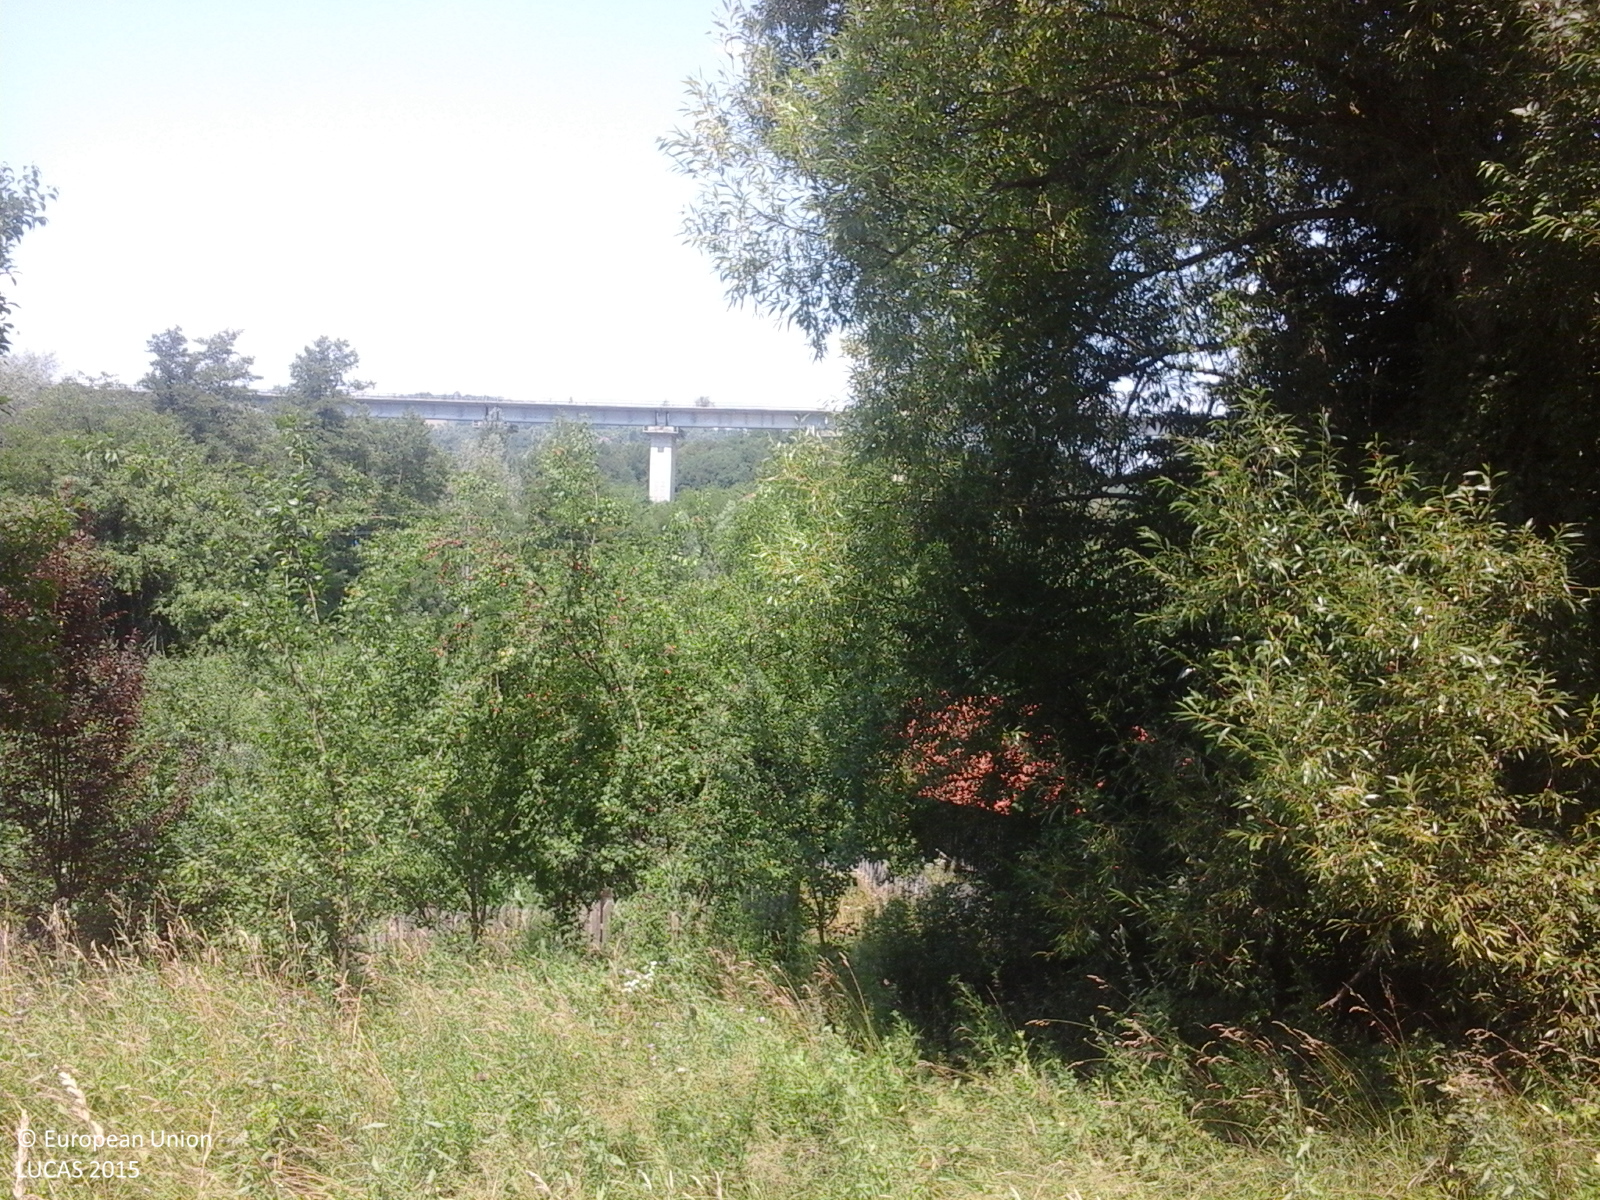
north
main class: Cropland
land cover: Other fruit trees and berries
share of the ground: 25 - 50 %
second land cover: Spontaneously vegetated surfaces
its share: > 75 %
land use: Agriculture (excluding fallow land and kitchen gardens)
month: July
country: RO
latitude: 45.0865
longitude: 24.4703
